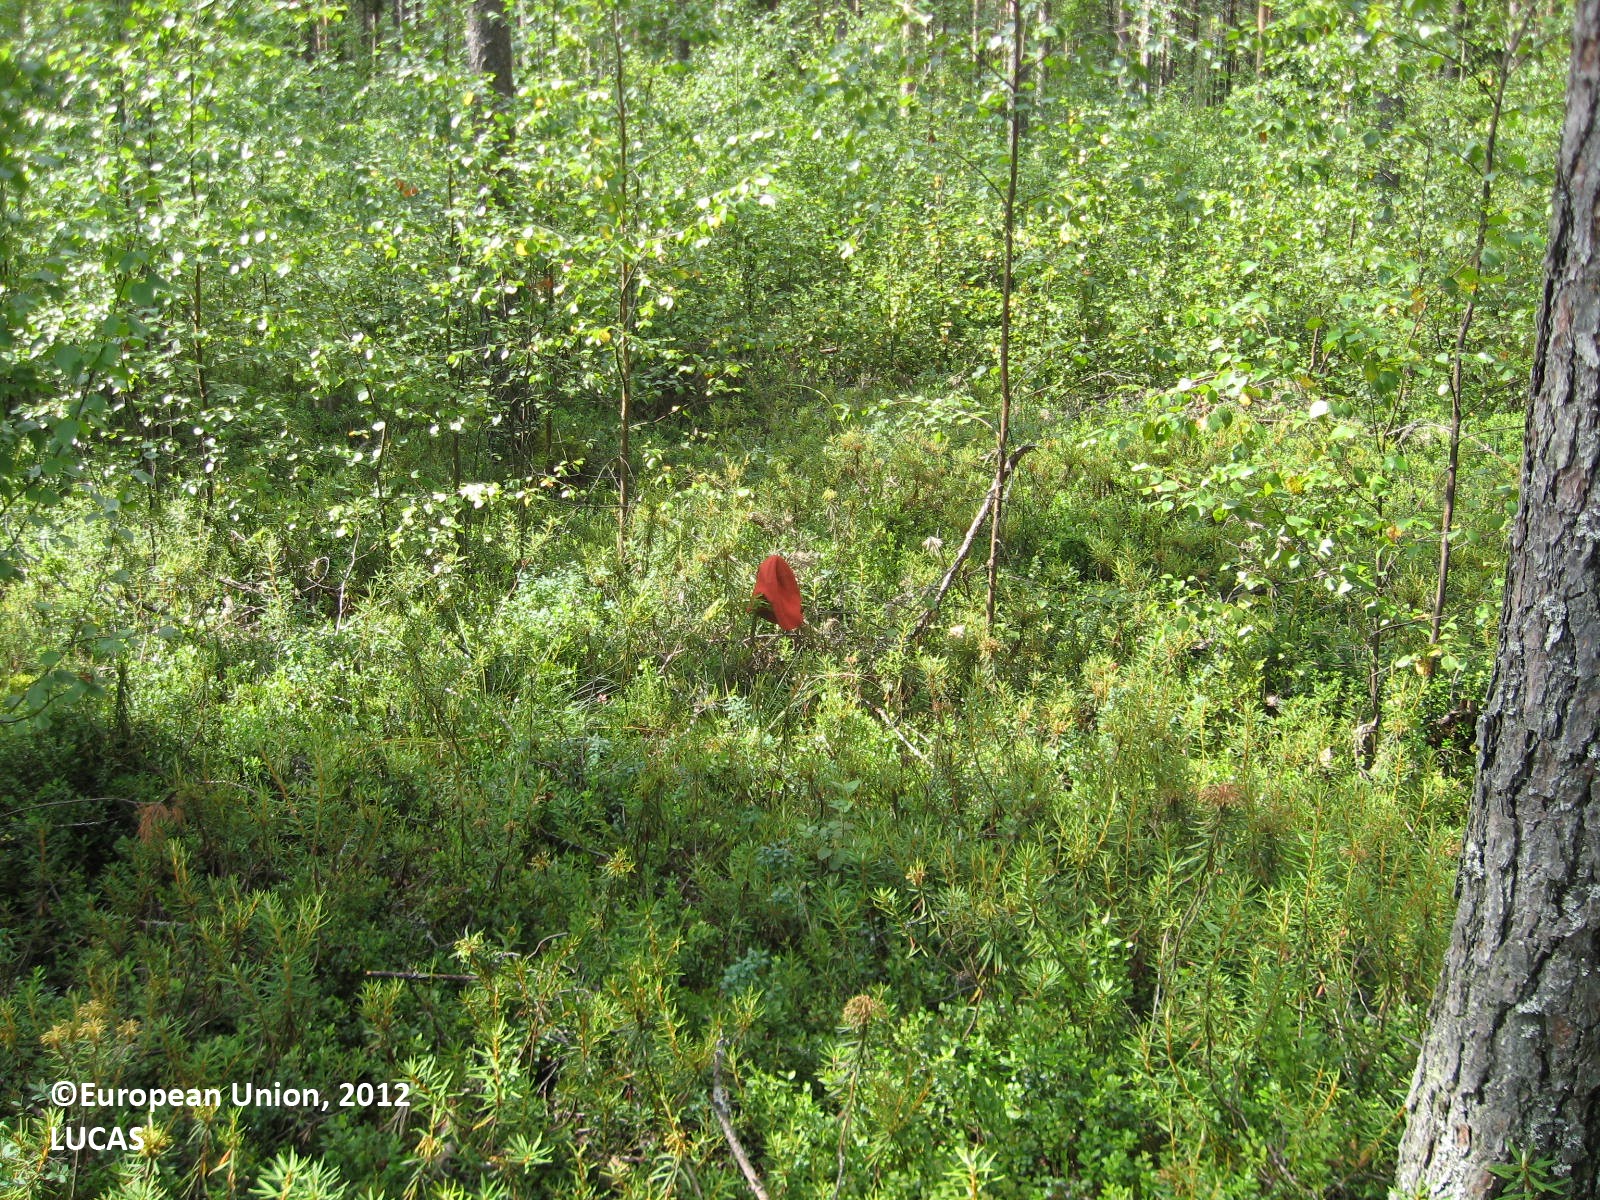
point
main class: Woodland
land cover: Pine dominated coniferous woodland
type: boreal forest
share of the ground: 50 - 75 %
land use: Forestry
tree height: > 5 m
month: July
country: FI
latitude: 62.0741
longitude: 22.6751
